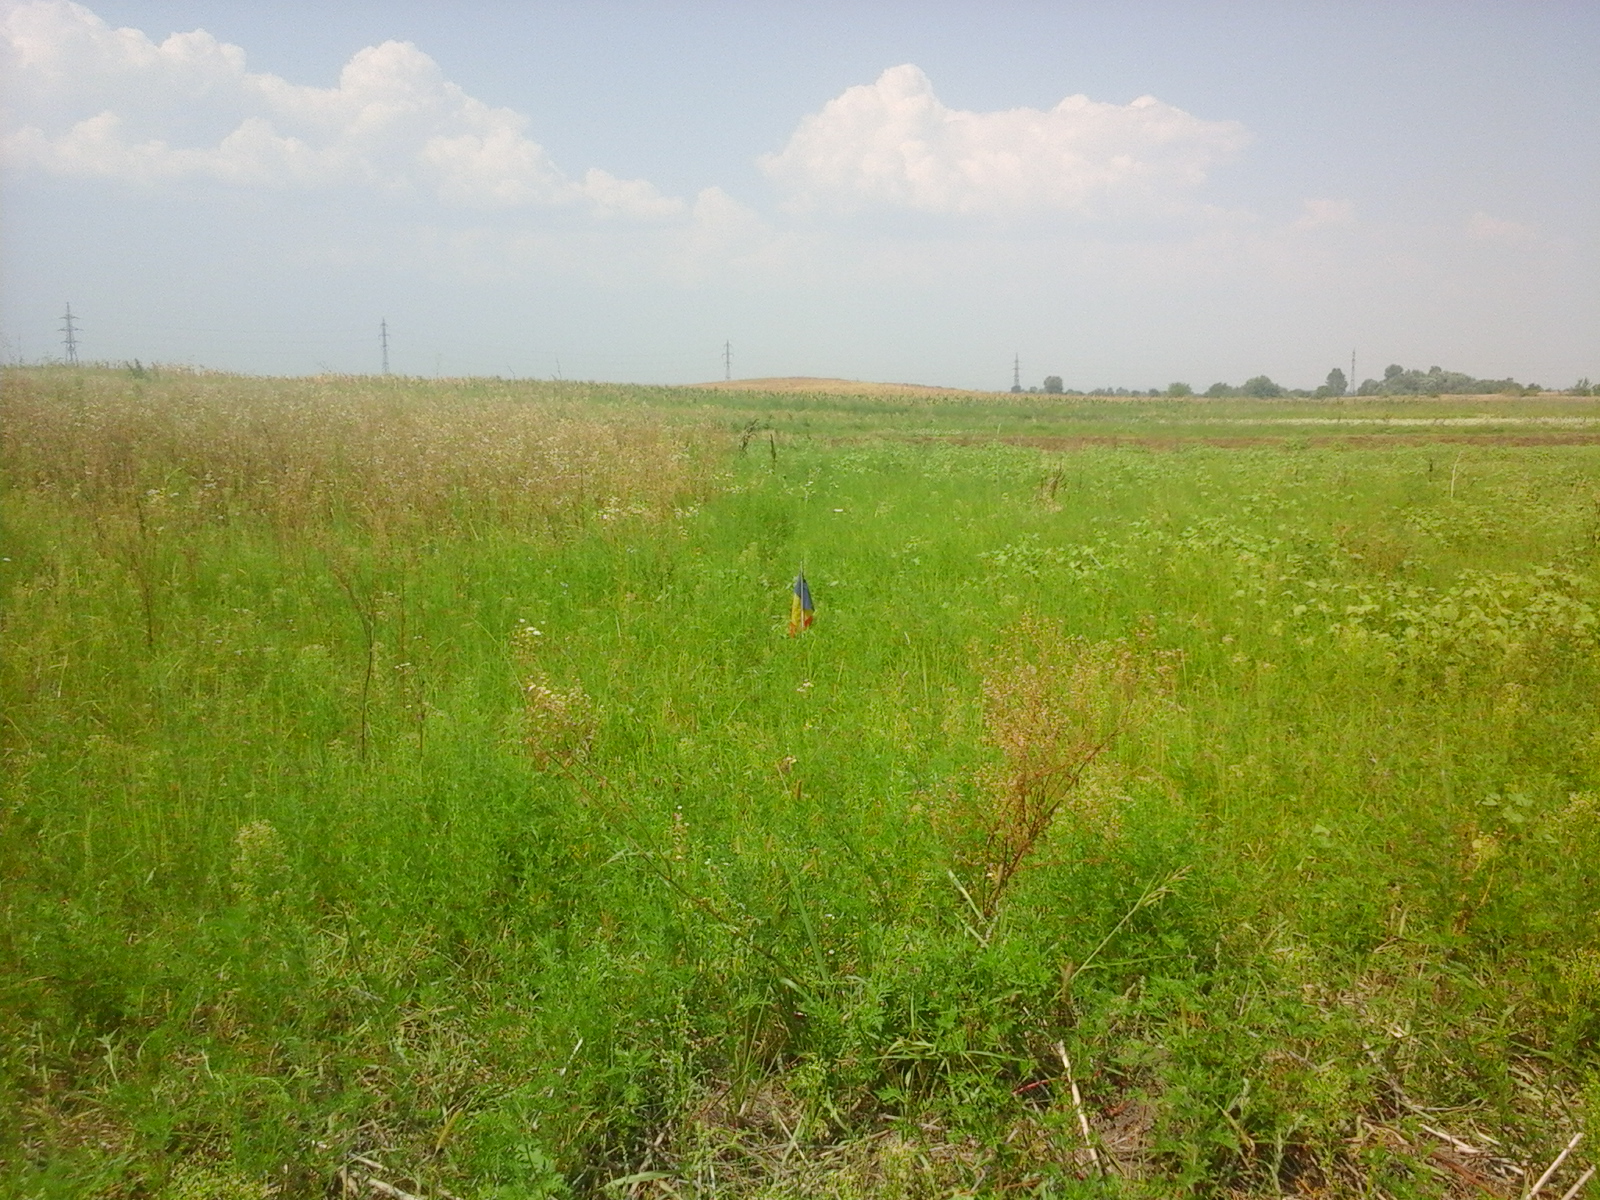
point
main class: Grassland
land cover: Spontaneously vegetated surfaces
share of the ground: > 75 %
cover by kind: herbaceous plants 100 %
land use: Fallow land
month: August
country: RO
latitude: 44.3811
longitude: 22.6029
